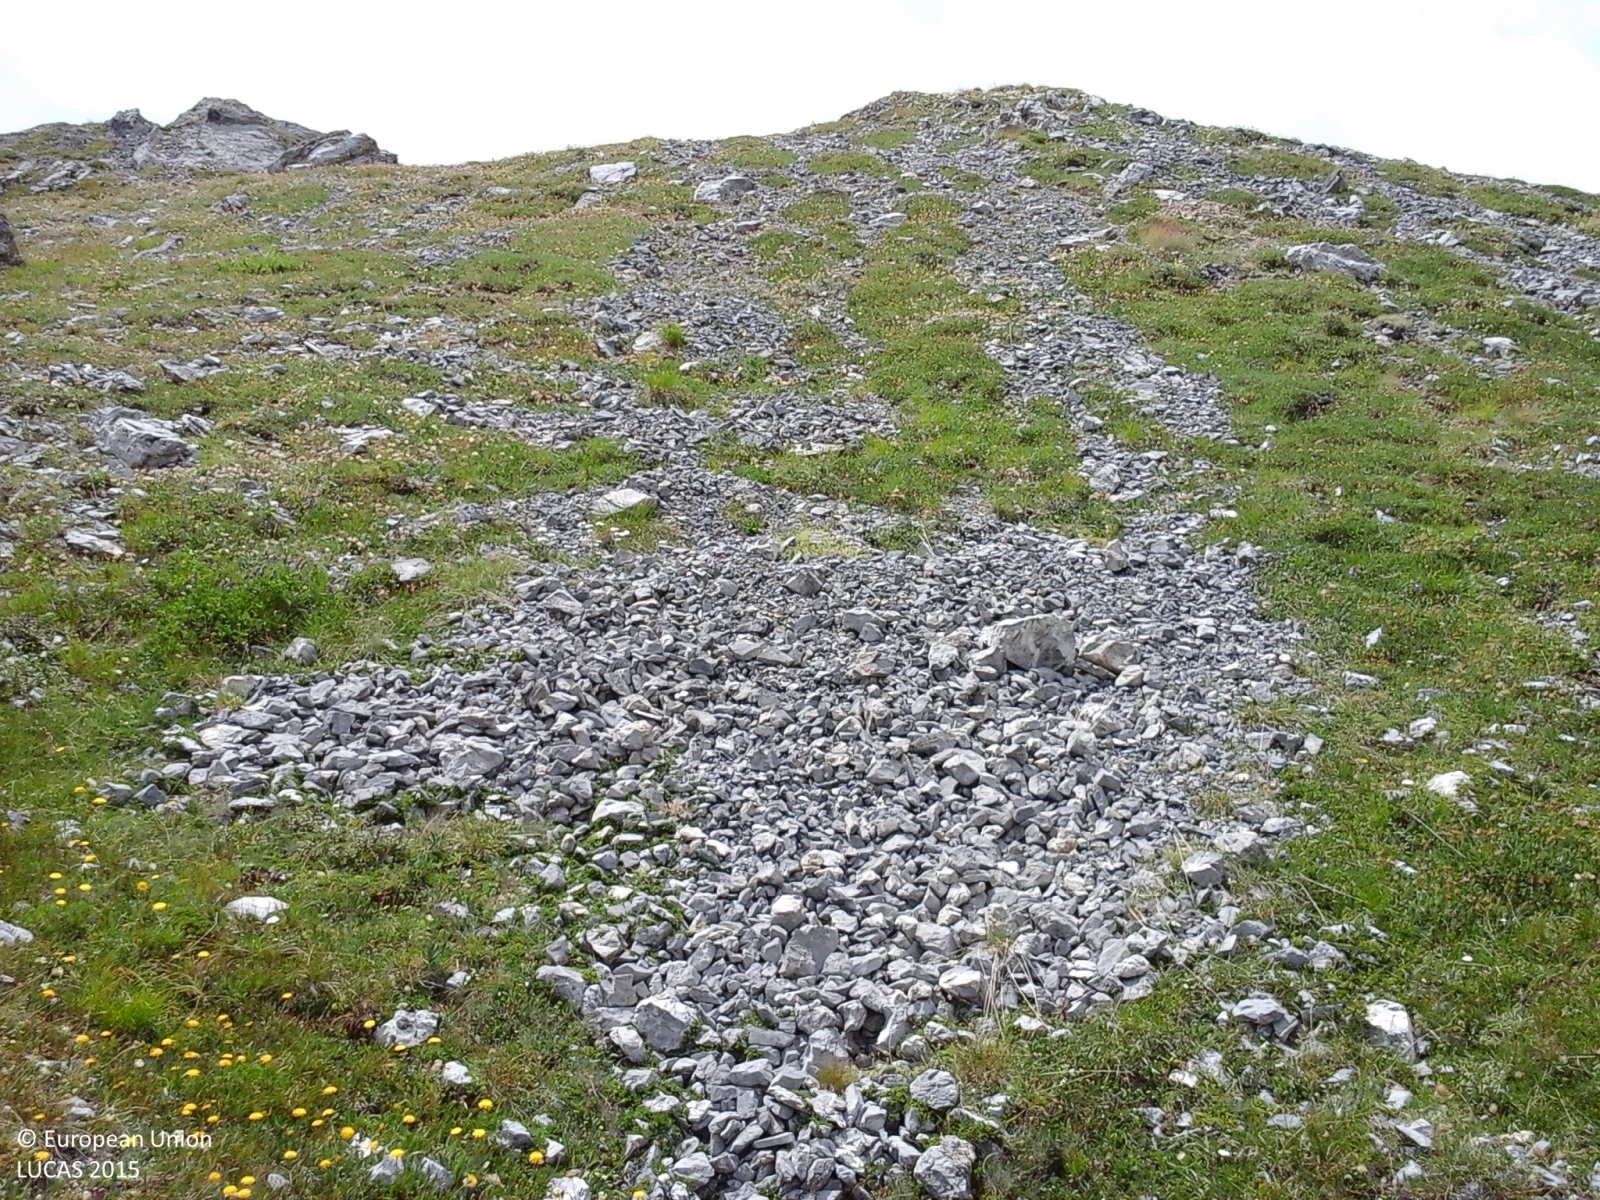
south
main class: Grassland
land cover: Grassland without tree/shrub cover
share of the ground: > 75 %
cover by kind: herbaceous plants 80 %, consolidated bare surface 20 %
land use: Agriculture (excluding fallow land and kitchen gardens)
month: July
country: IT
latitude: 44.3810
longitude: 7.0563
